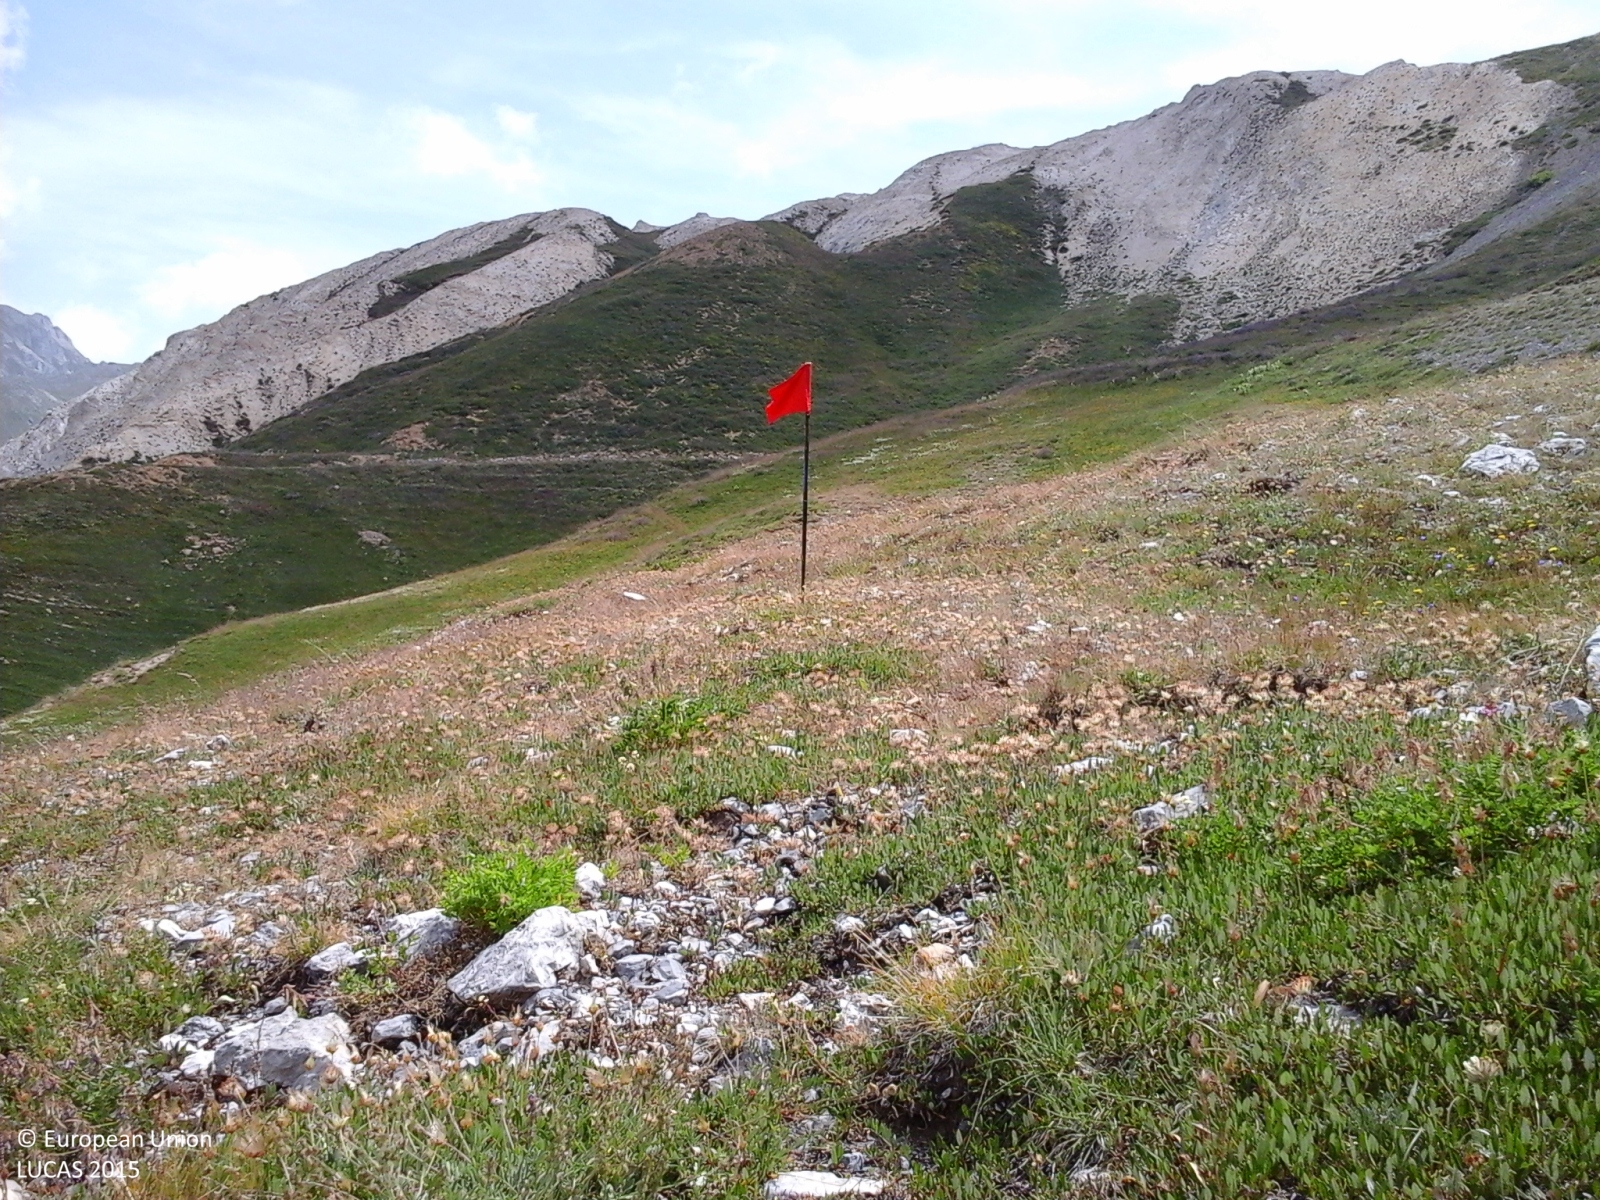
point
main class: Grassland
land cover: Grassland without tree/shrub cover
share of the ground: > 75 %
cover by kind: herbaceous plants 80 %, consolidated bare surface 20 %
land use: Agriculture (excluding fallow land and kitchen gardens)
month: July
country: IT
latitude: 44.3810
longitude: 7.0563
